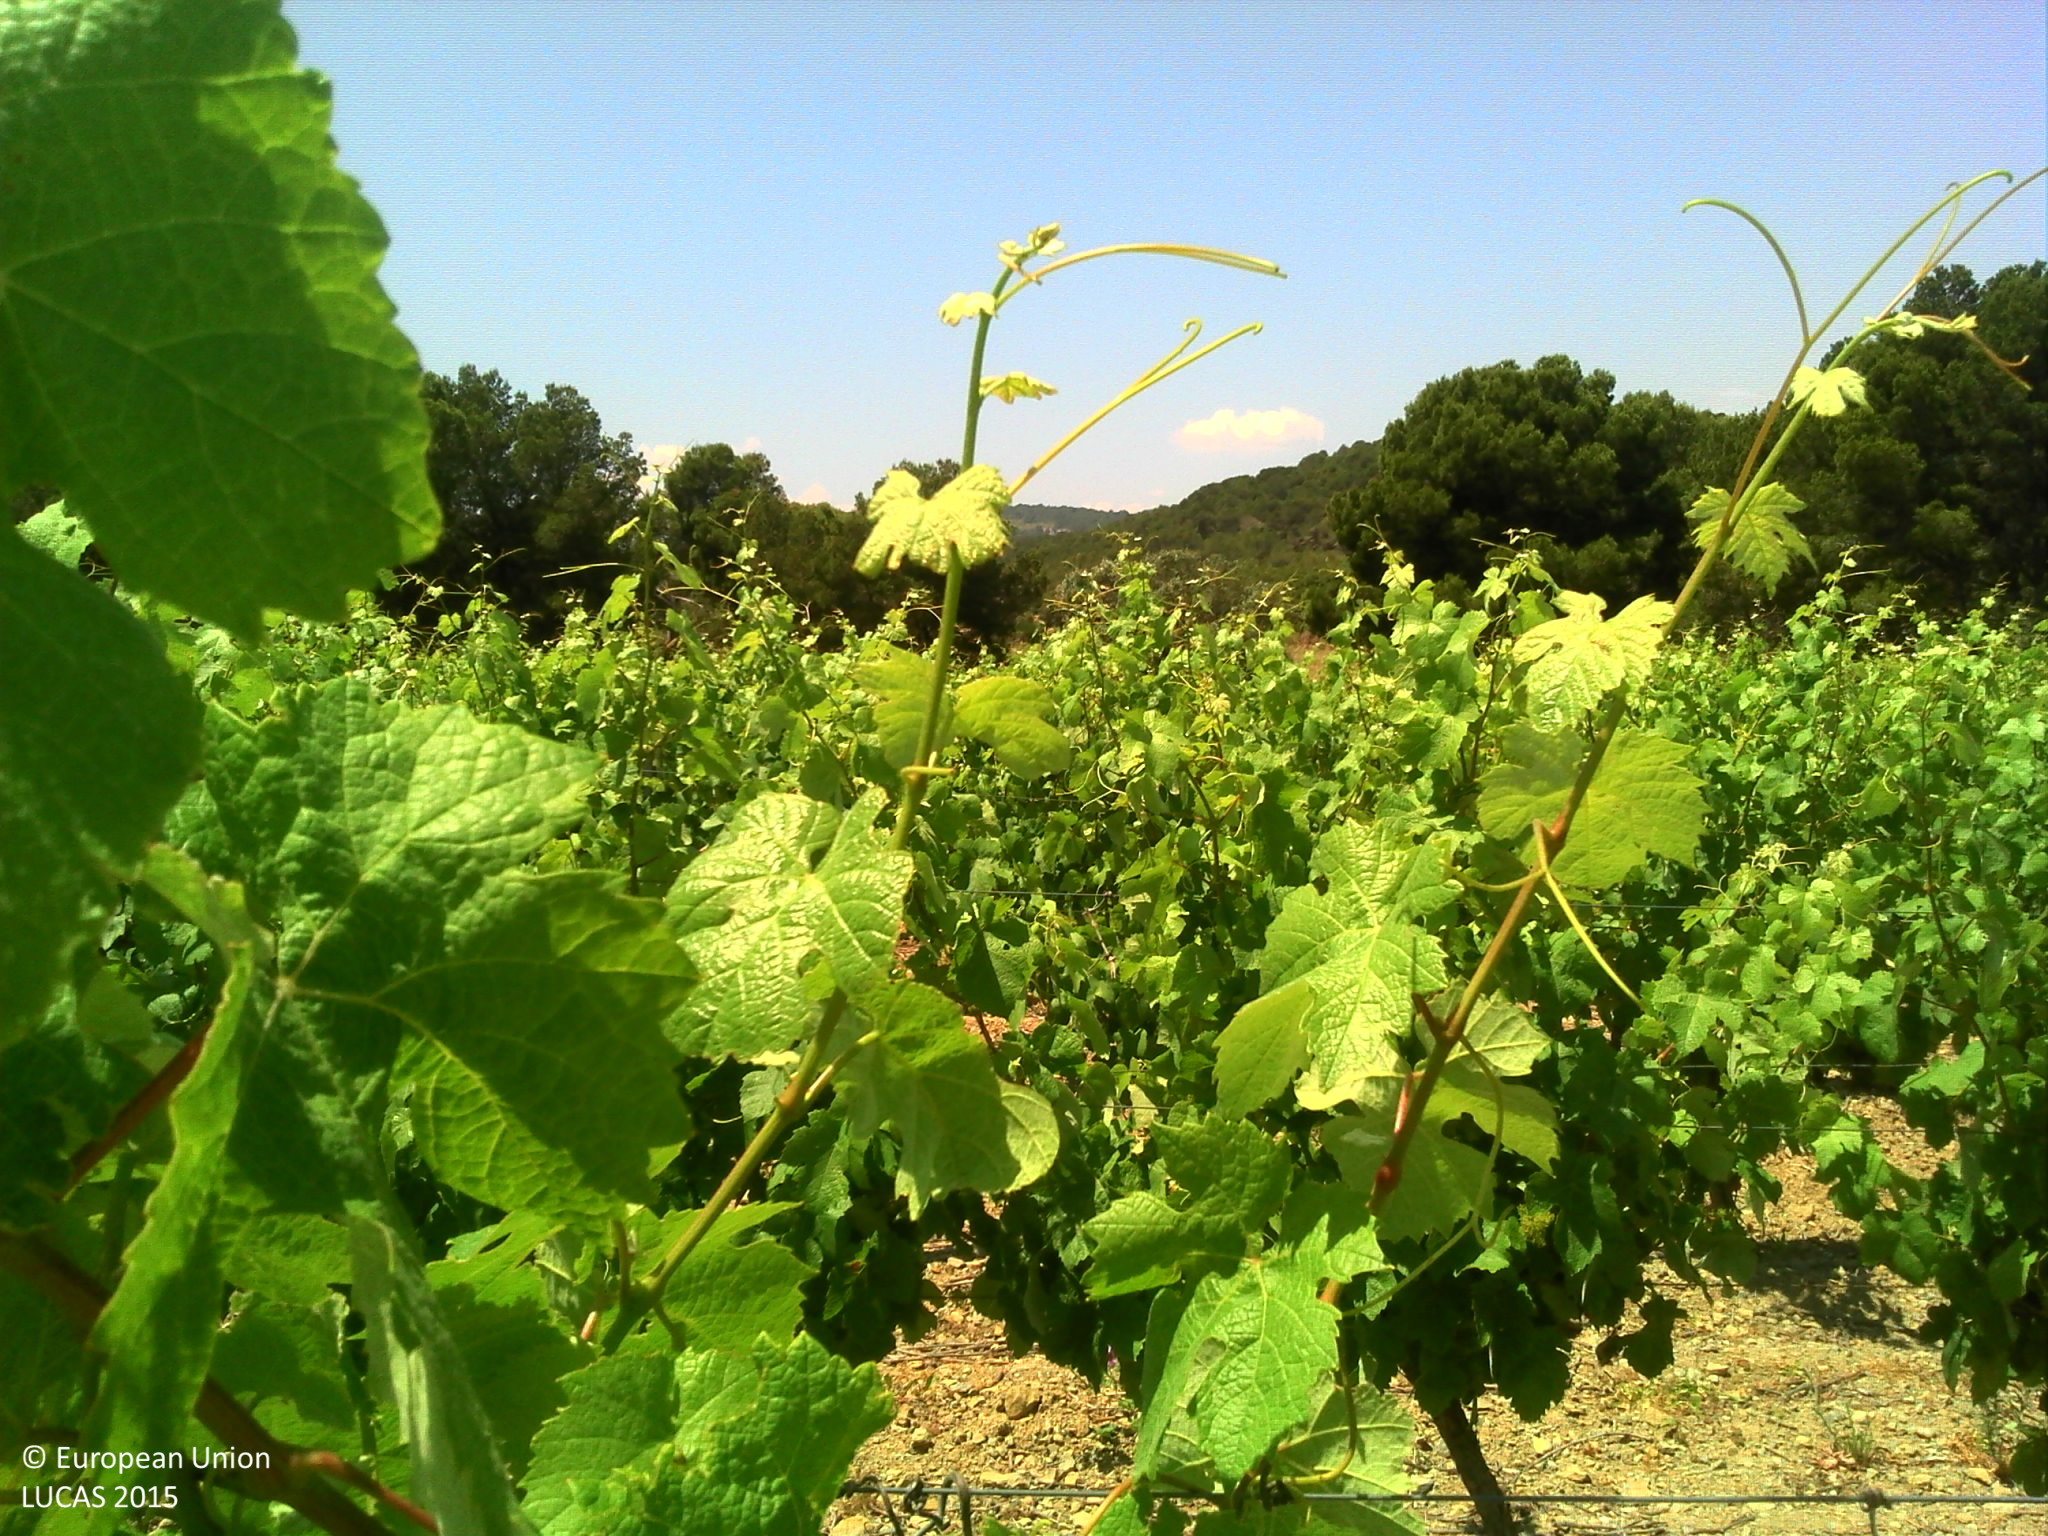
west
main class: Cropland
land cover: Vineyards
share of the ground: 50 - 75 %
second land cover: Other bare soil
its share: > 75 %
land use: Agriculture (excluding fallow land and kitchen gardens)
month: June
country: FR
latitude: 43.1260
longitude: 3.1145
